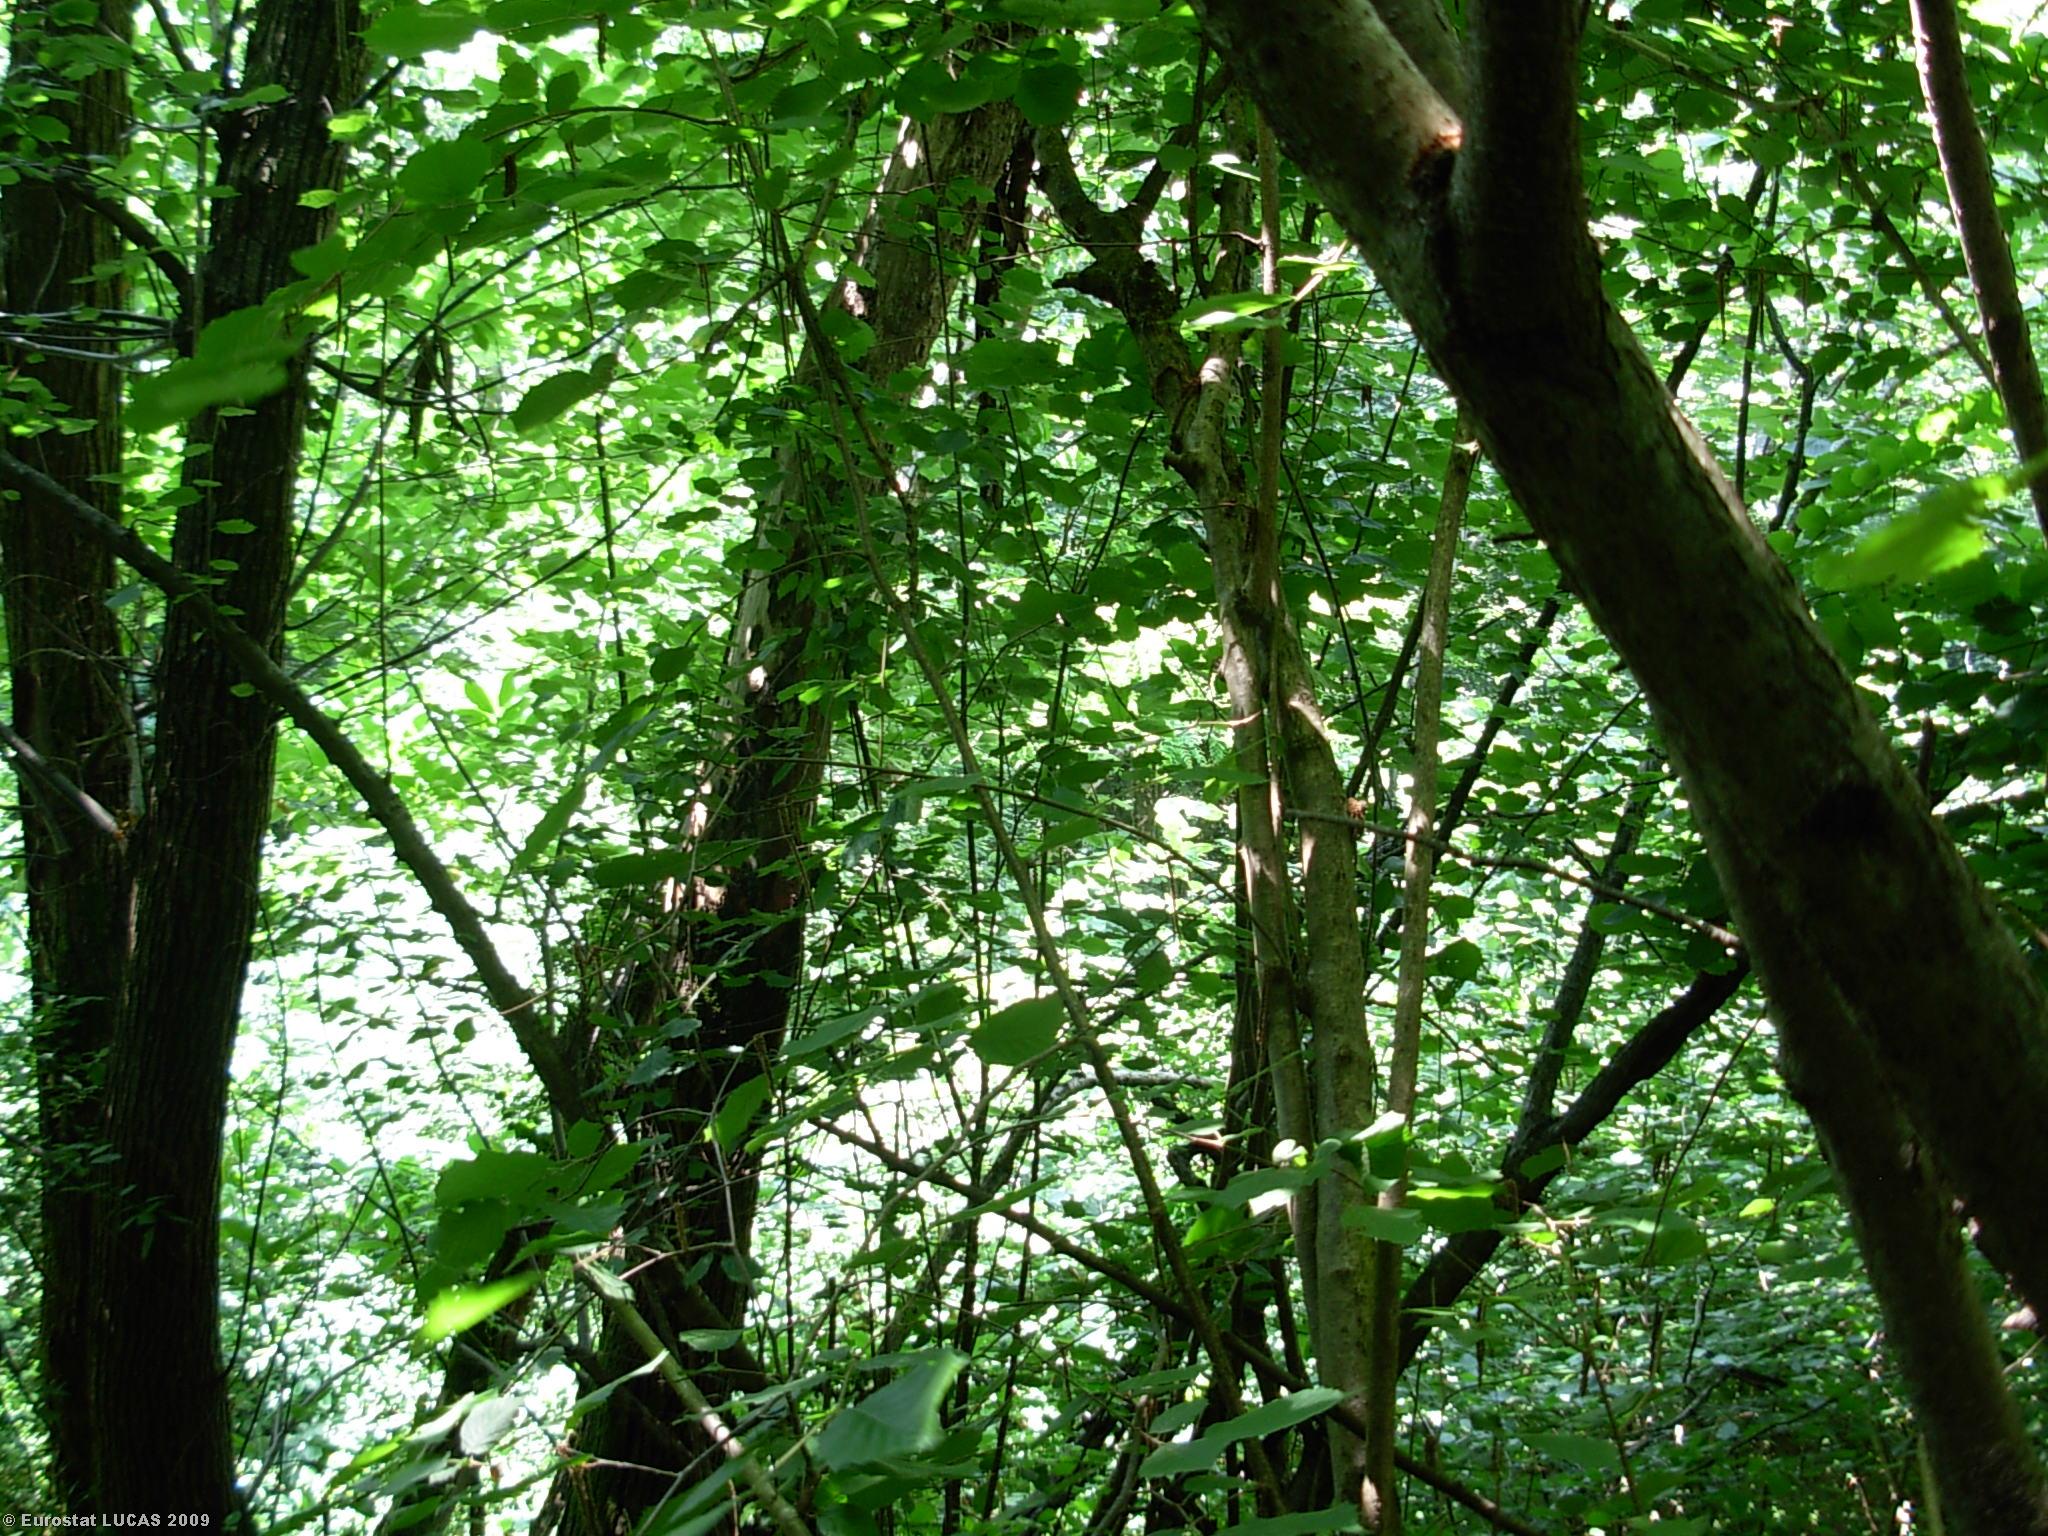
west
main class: Woodland
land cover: Broadleaved woodland
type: mountainous beech forest
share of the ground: > 75 %
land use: Unused
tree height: > 5 m
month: June
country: IT
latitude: 45.5575
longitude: 10.4476
